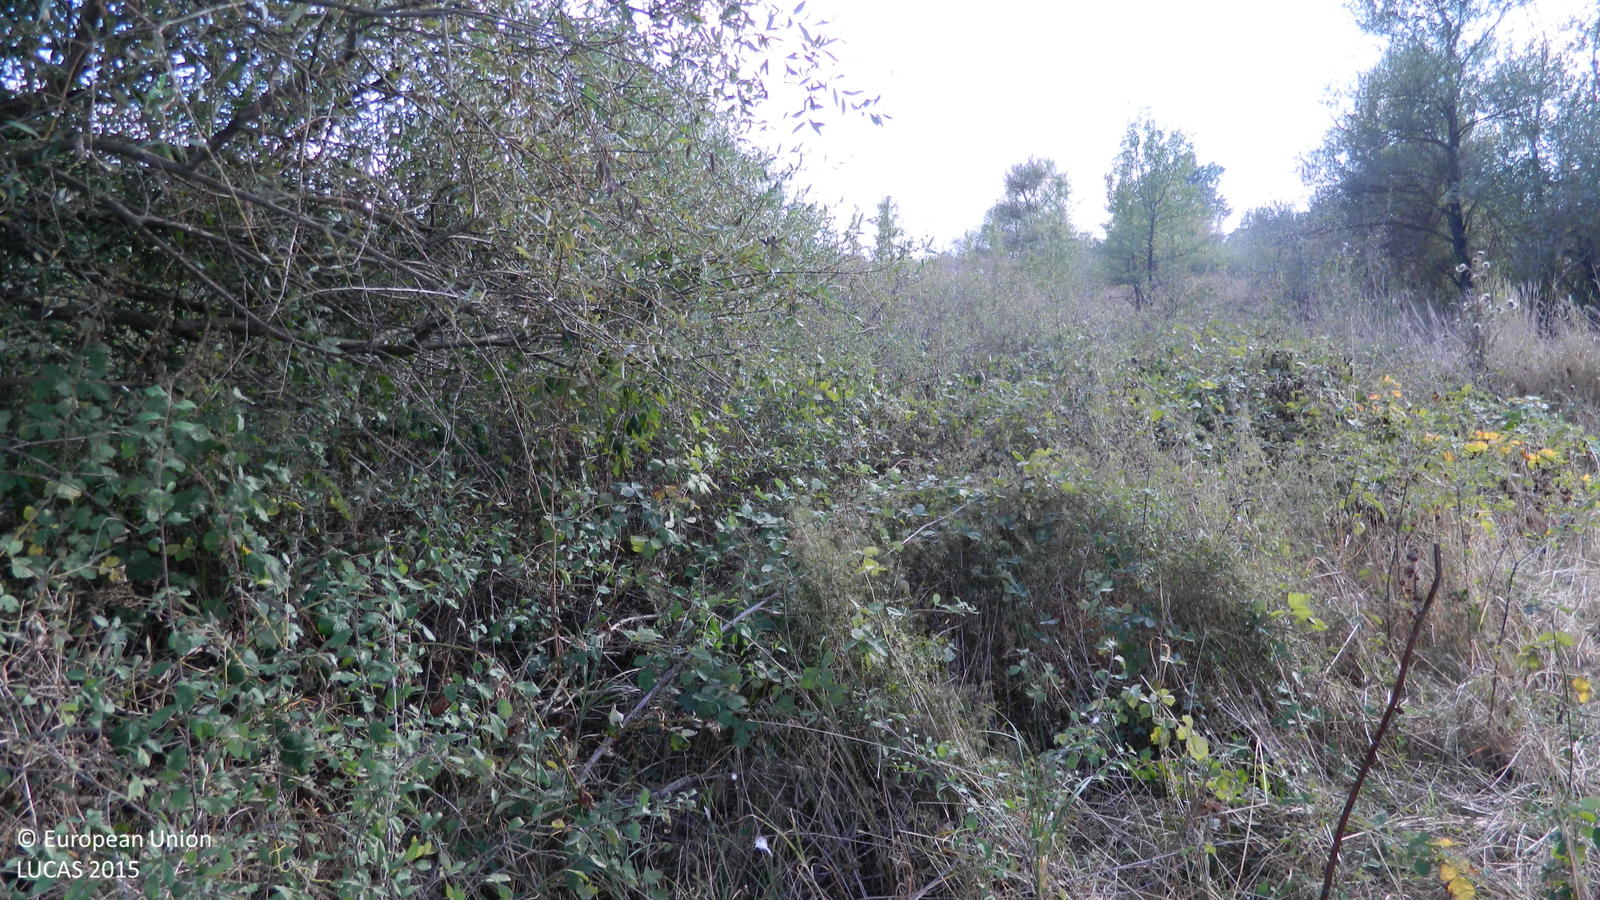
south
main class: Shrubland
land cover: Shrubland with sparse tree cover
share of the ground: > 75 %
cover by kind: shrubs 95 %, broadleaved forest trees 5 %
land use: Semi-natural and natural areas not in use
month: September
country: BG
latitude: 41.7598
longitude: 25.7624
